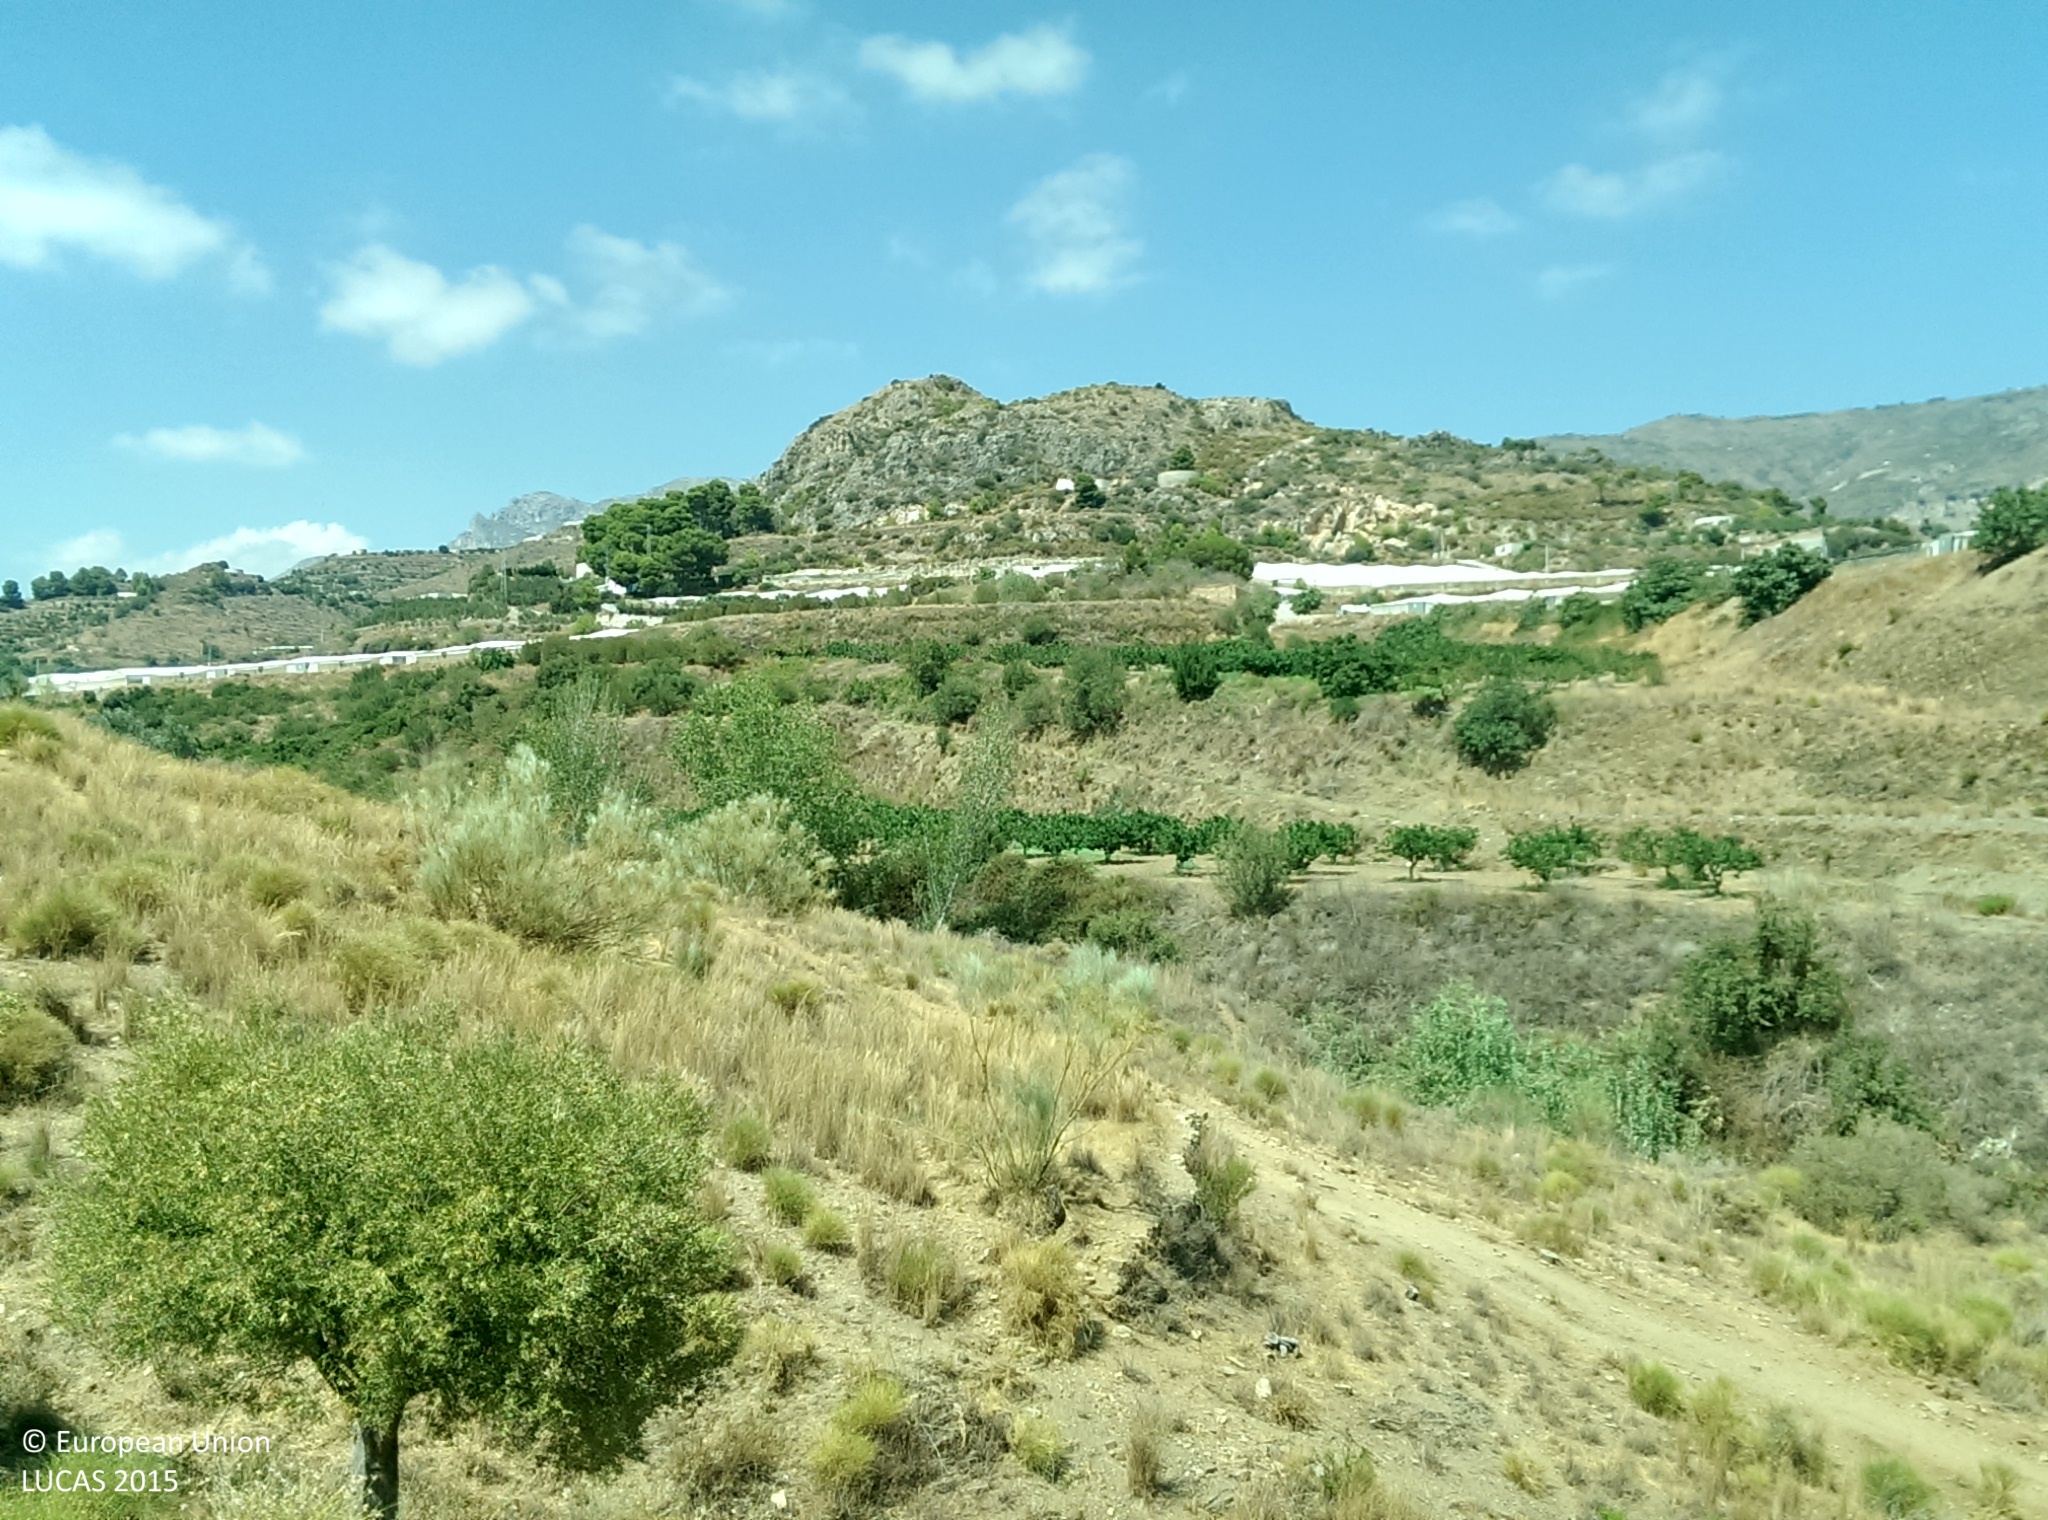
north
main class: Cropland
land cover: Nuts trees
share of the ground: 10 - 25 %
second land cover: Spontaneously vegetated surfaces
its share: 50 - 75 %
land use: Agriculture (excluding fallow land and kitchen gardens)
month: August
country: ES
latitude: 36.7811
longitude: -3.6194
